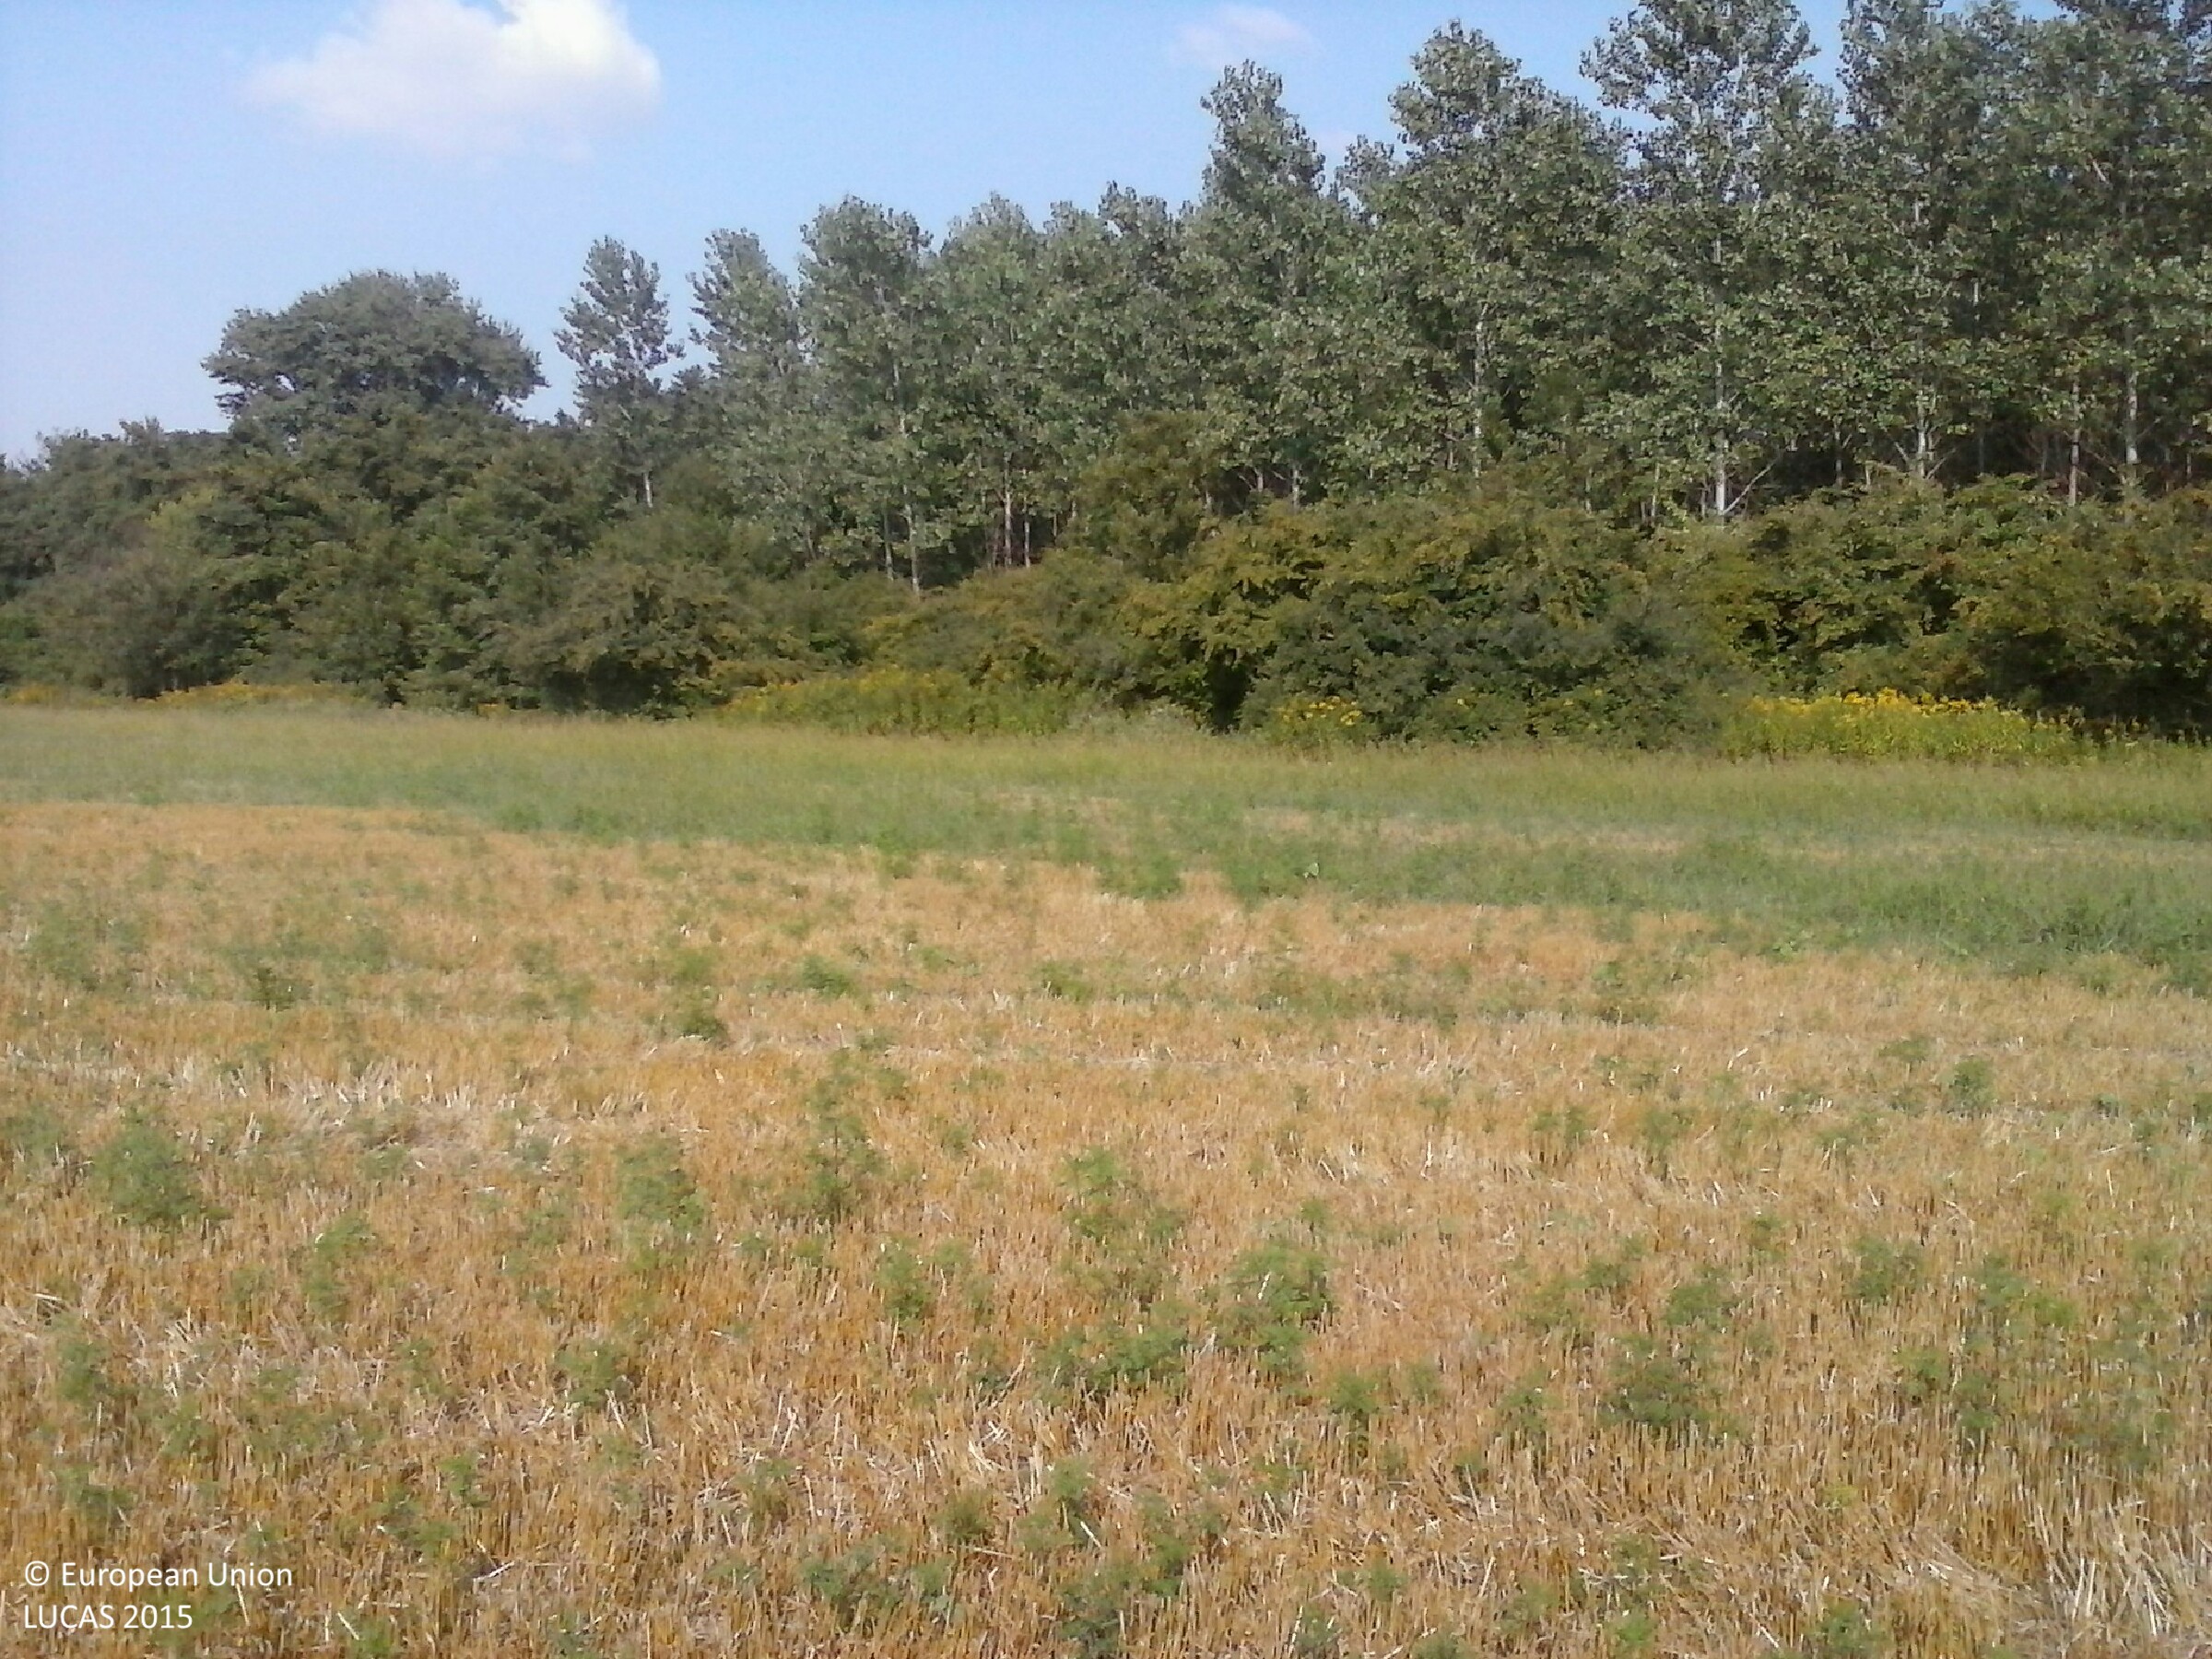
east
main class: Cropland
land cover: Common wheat
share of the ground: 10 - 25 %
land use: Agriculture (excluding fallow land and kitchen gardens)
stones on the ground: < 10 %
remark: Harvested field
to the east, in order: Common wheat; Grass margins; Shrubland with sparse tree cover; Broadleaved woodland
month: April
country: HU
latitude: 45.8263
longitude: 18.3351
